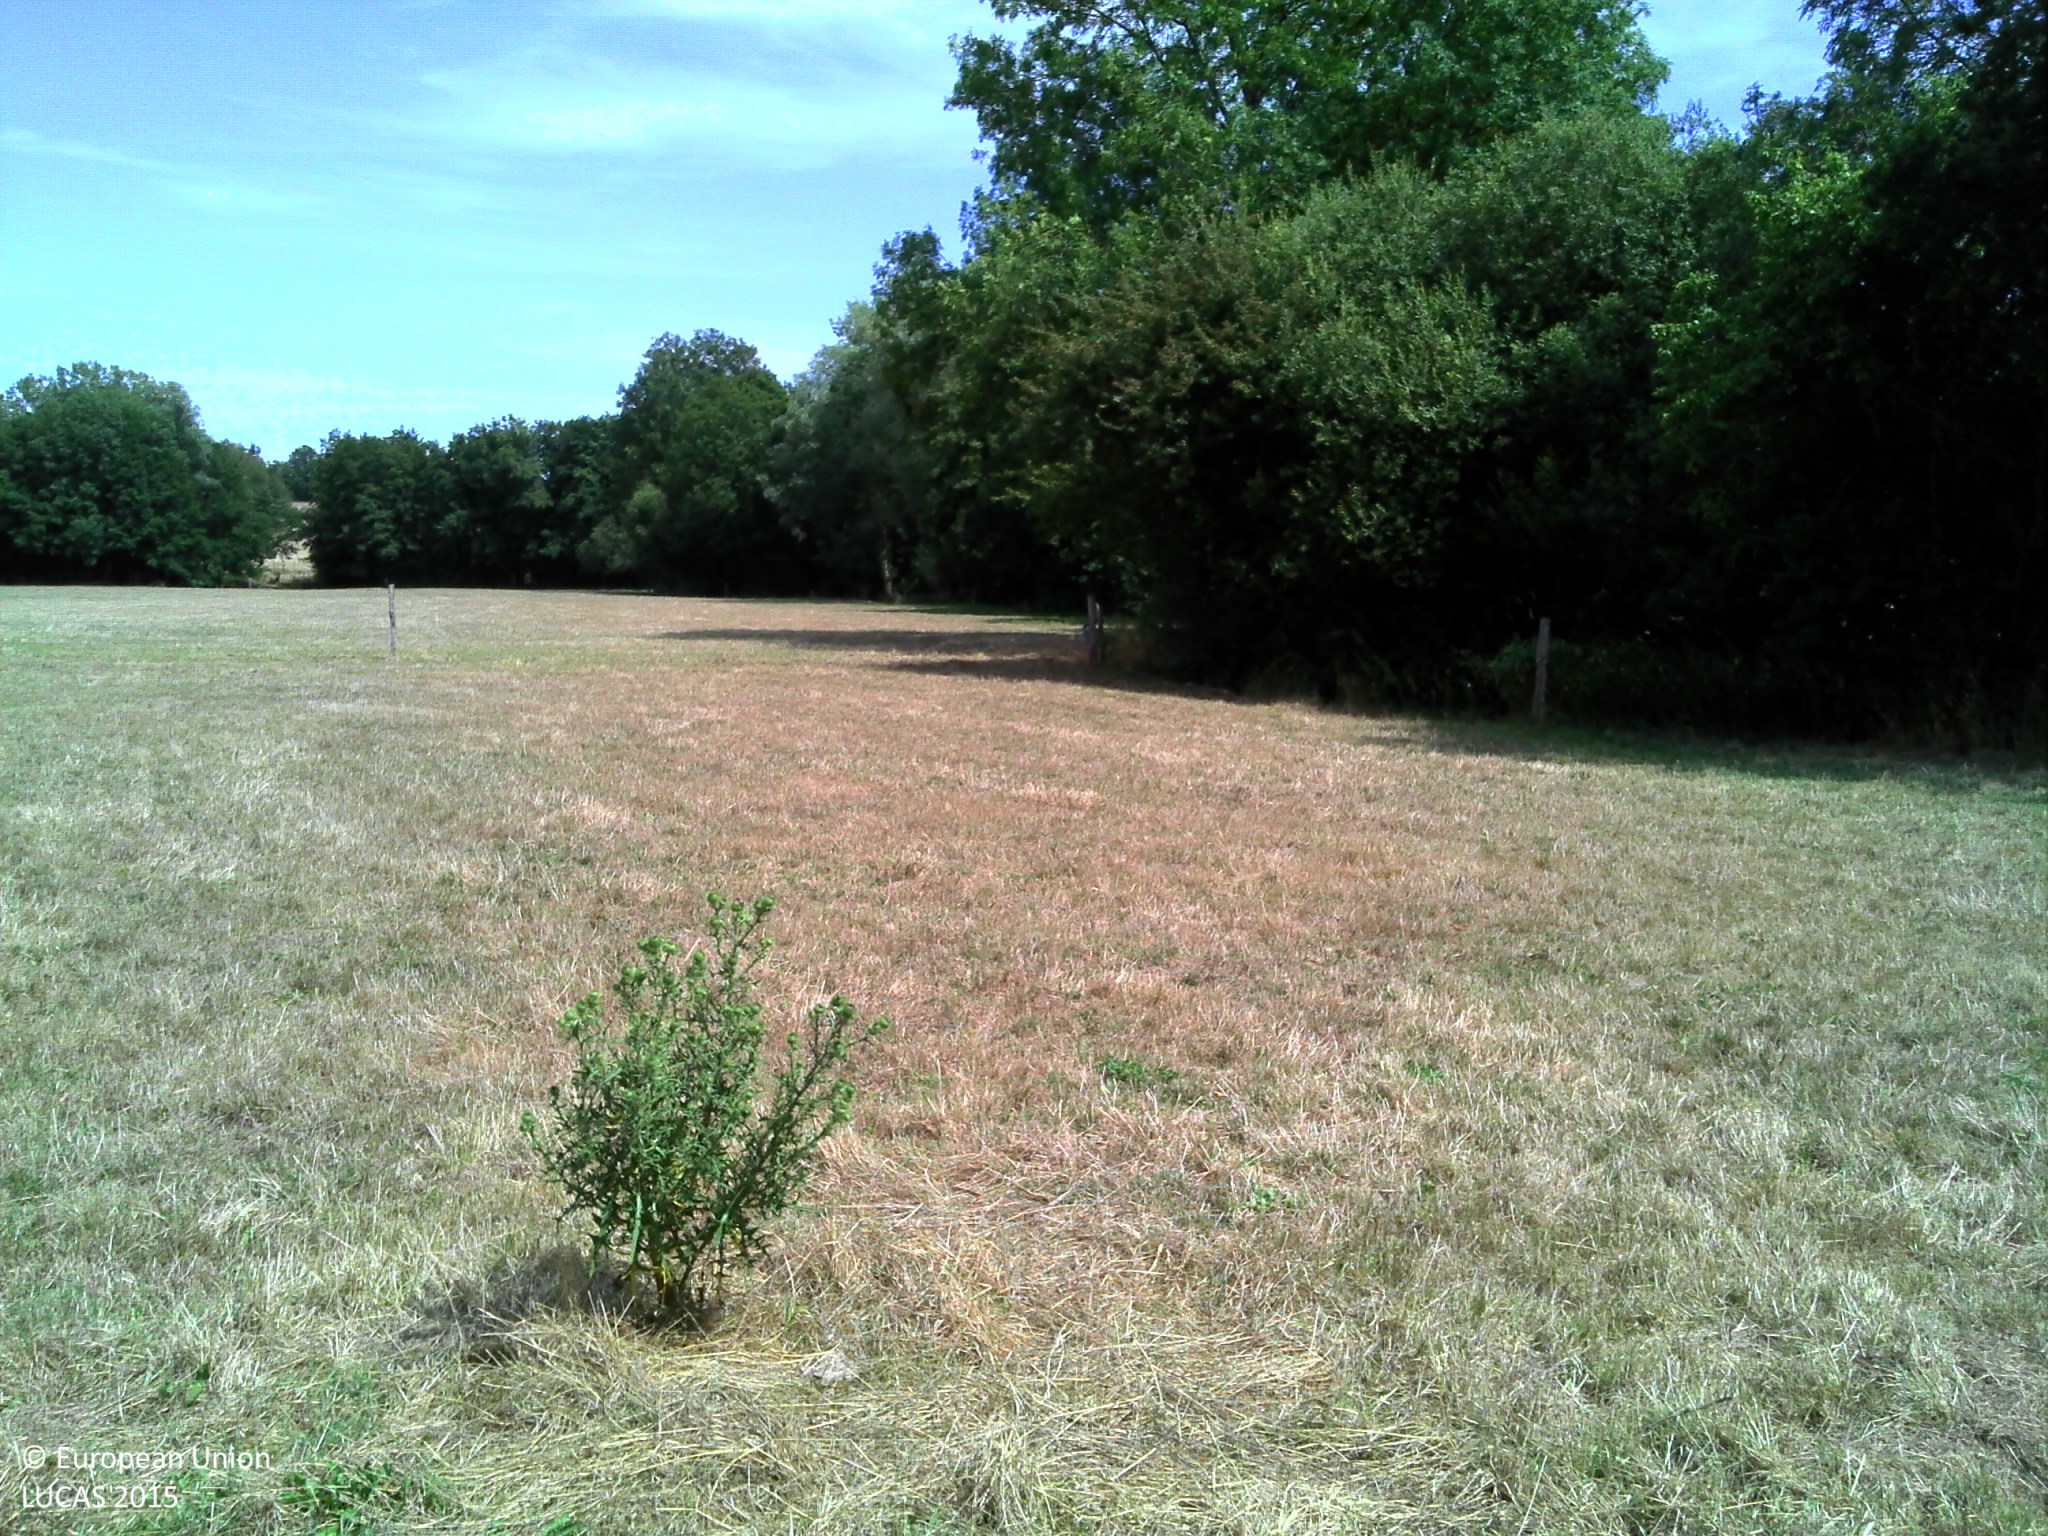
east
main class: Grassland
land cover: Grassland without tree/shrub cover
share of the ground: > 75 %
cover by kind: herbaceous plants 100 %
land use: Agriculture (excluding fallow land and kitchen gardens)
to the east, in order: Grassland without tree/shrub cover; Fences; Grassland without tree/shrub cover; Fences; Lines of trees; Inland fresh running water; Lines of trees; Fences; Grassland without tree/shrub cover; Broadleaved woodland; Grassland without tree/shrub cover; Fences; Grassland without tree/shrub cover; Lines of trees; Grassland without tree/shrub cover
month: August
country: FR
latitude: 47.7705
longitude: 3.0684
